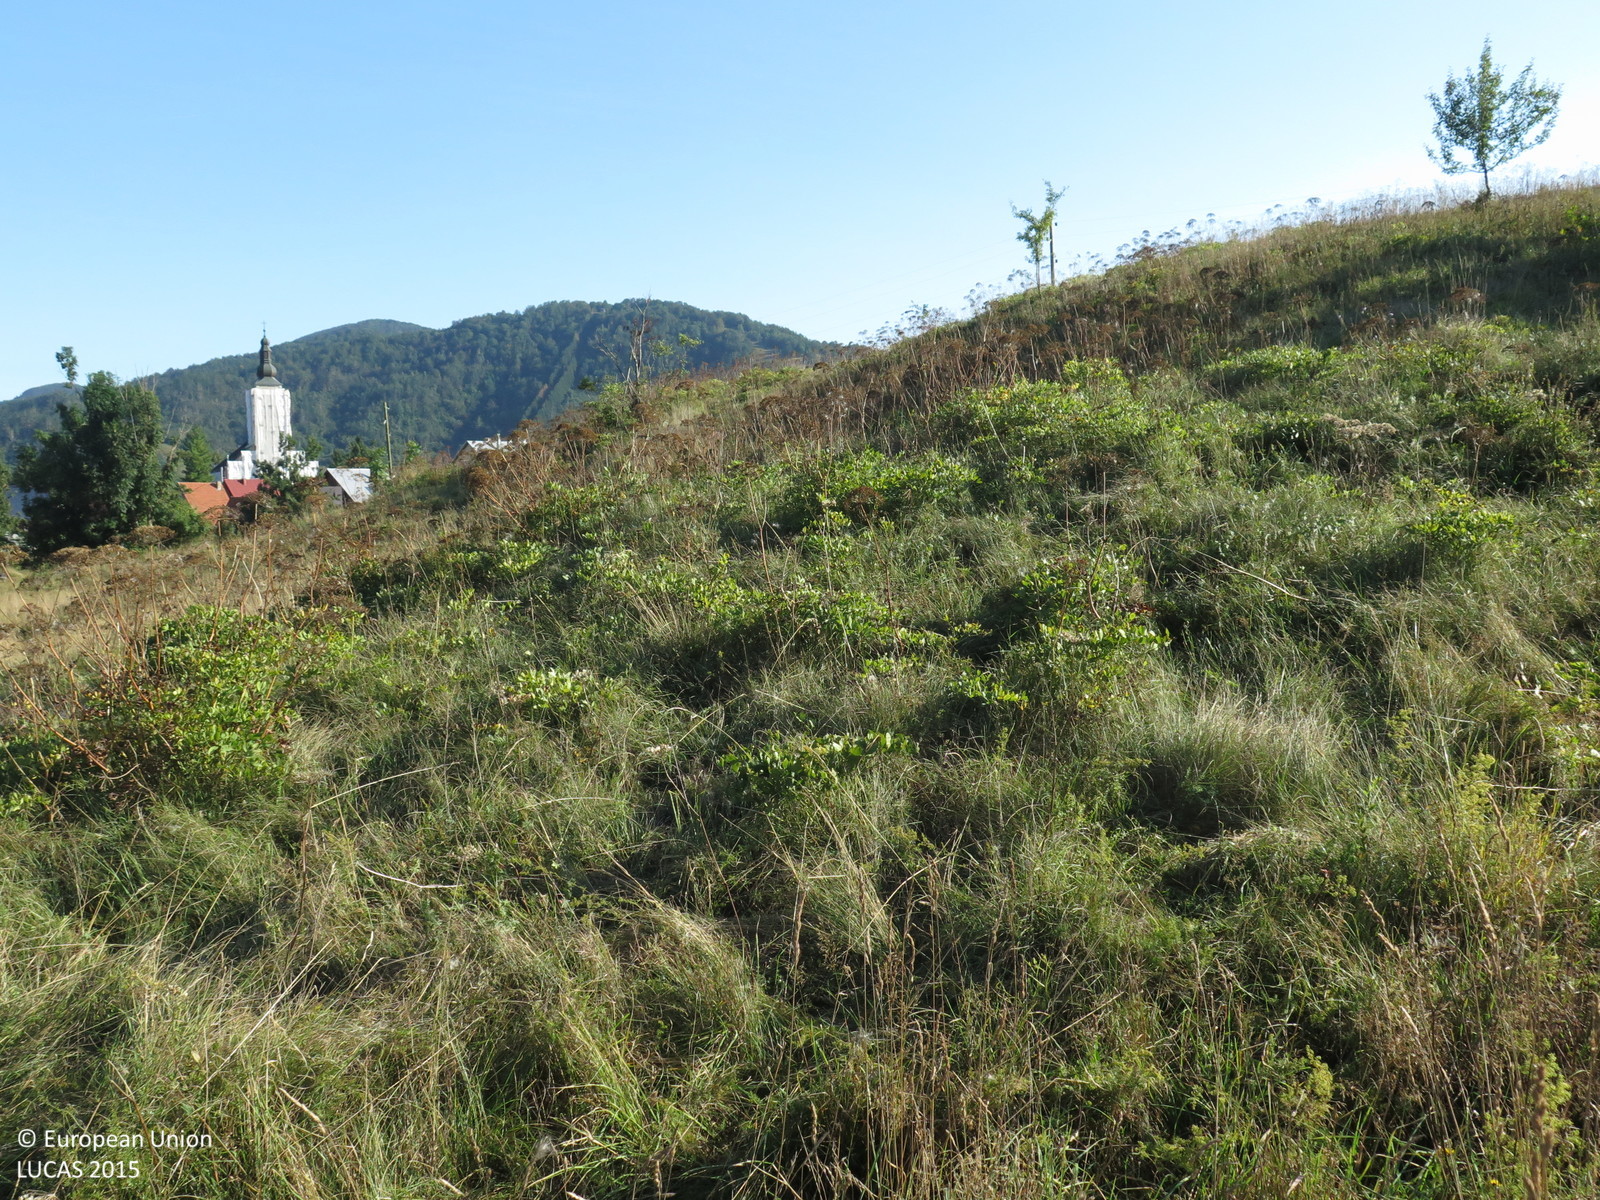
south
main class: Grassland
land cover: Grassland without tree/shrub cover
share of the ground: > 75 %
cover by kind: herbaceous plants 95 %, shrubs 5 %
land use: Agriculture (excluding fallow land and kitchen gardens)
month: August
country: HR
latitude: 45.3205
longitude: 14.8556
